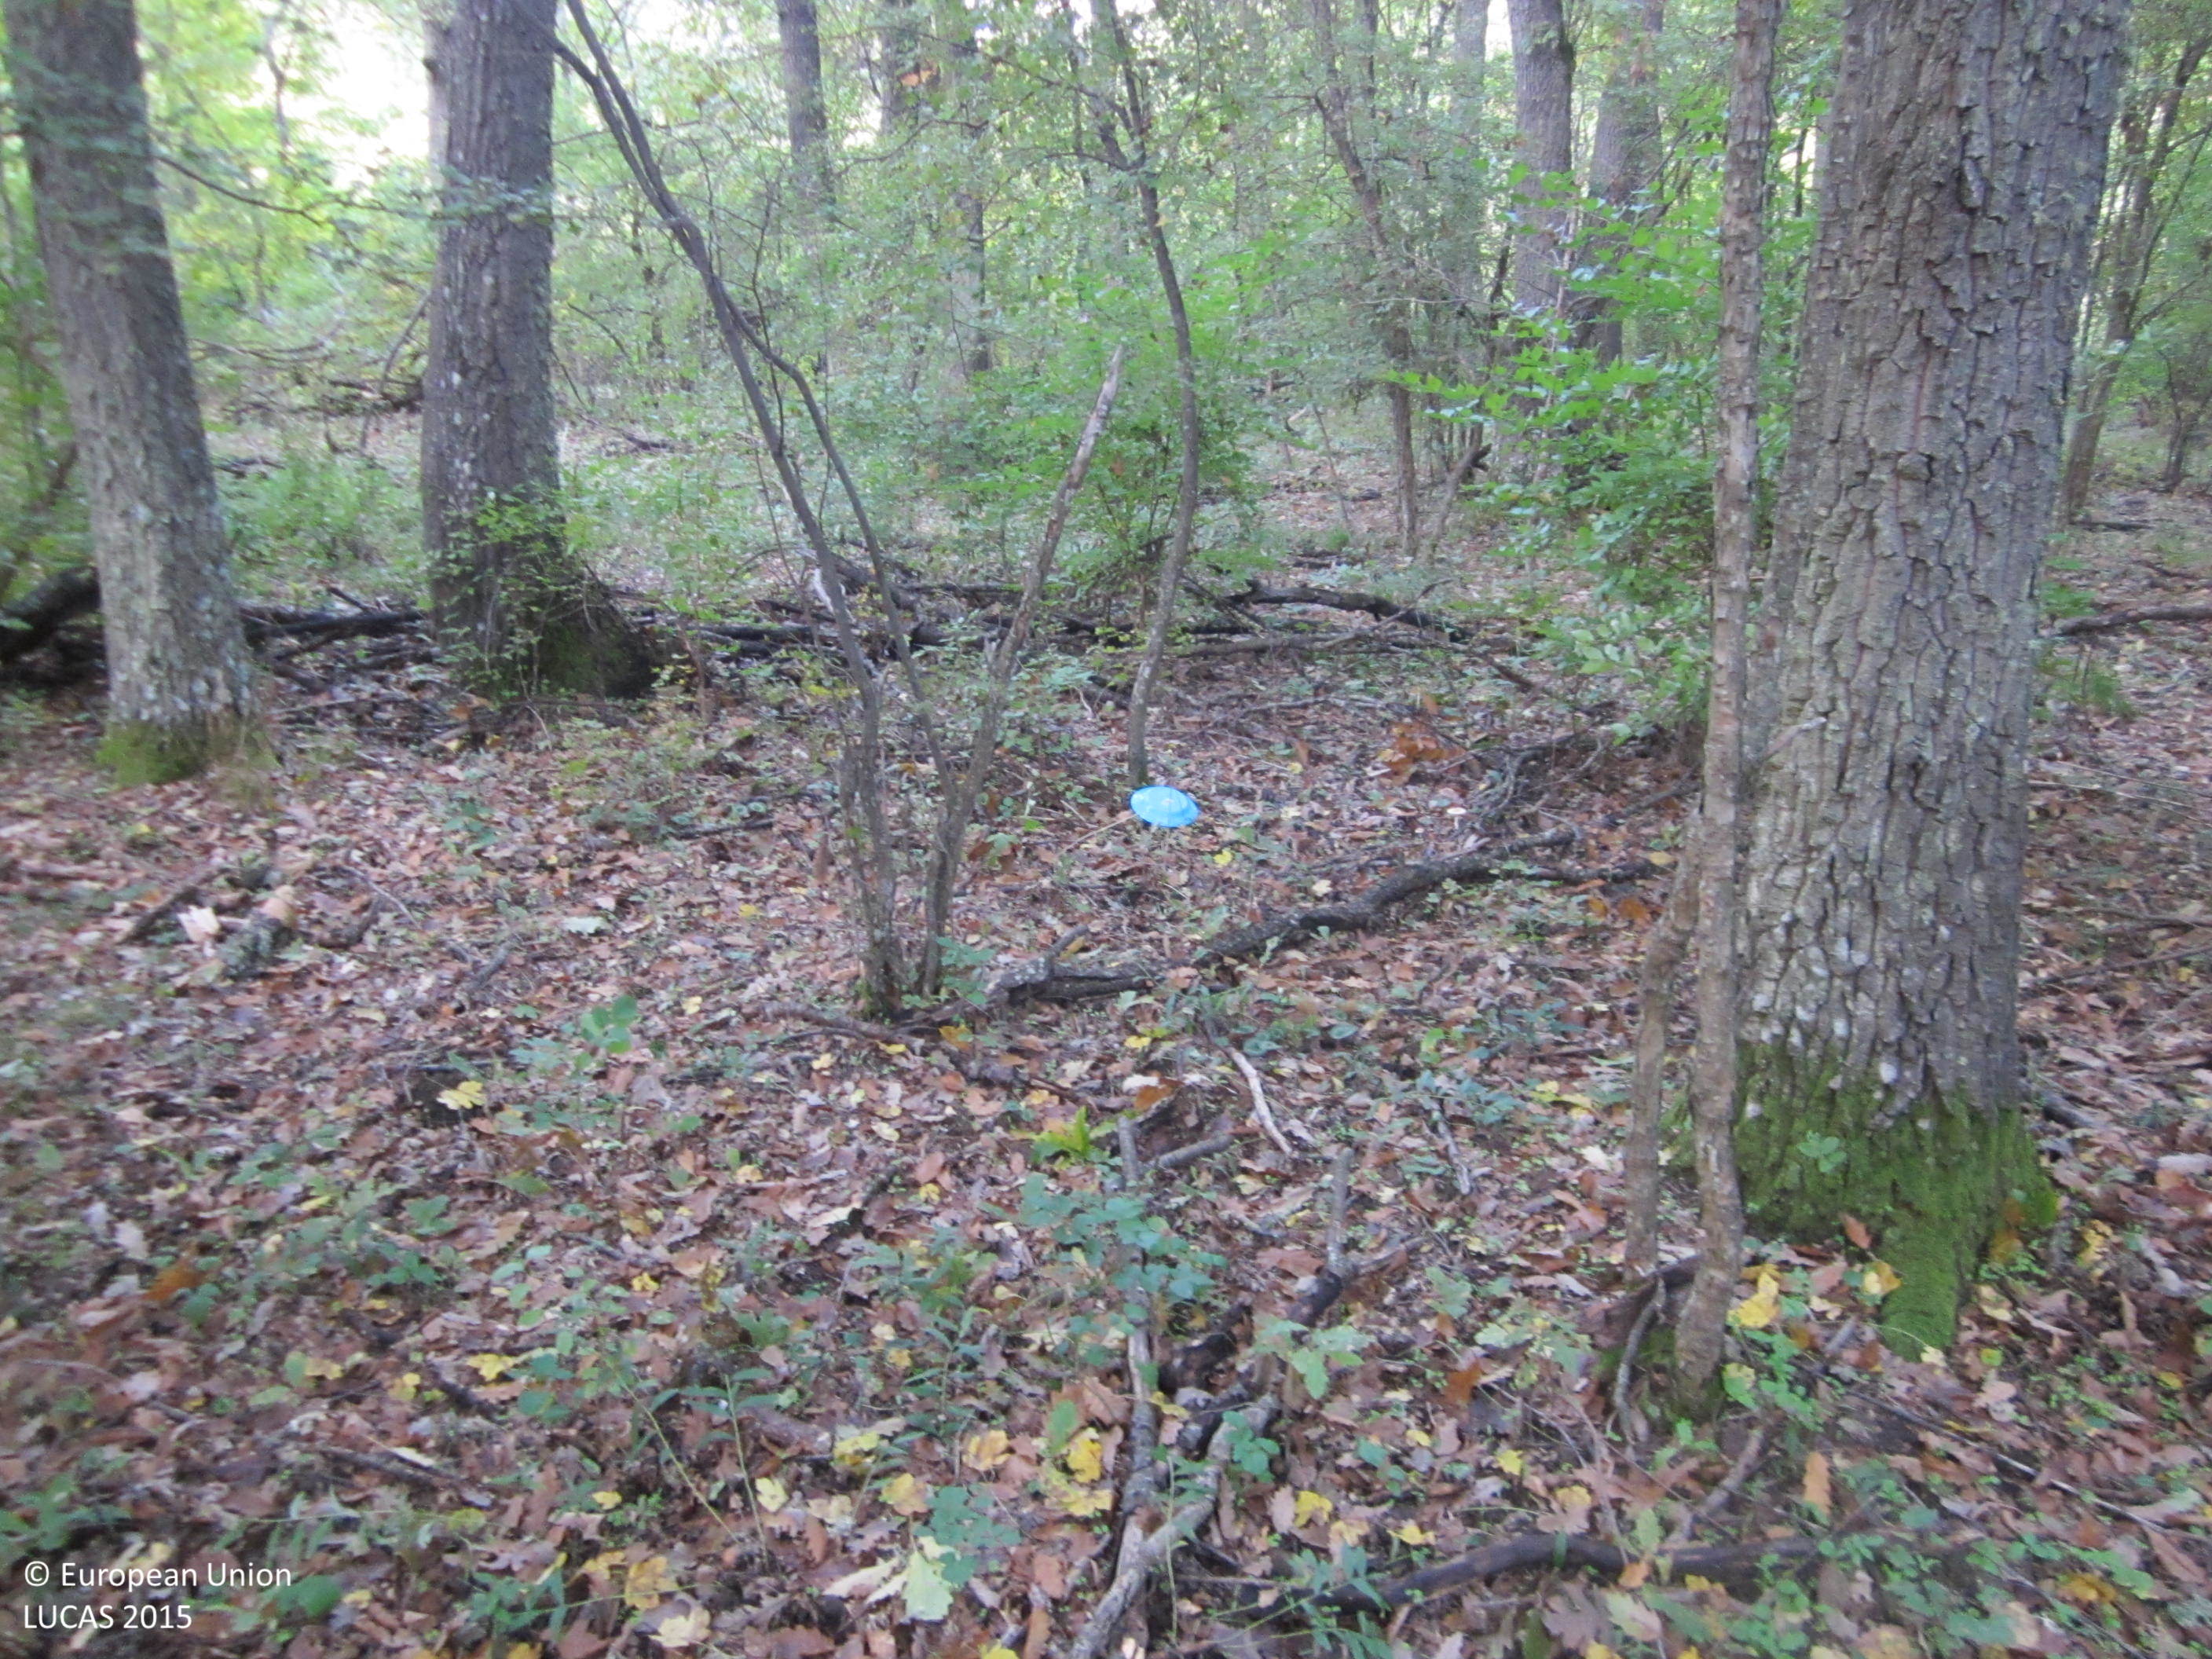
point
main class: Woodland
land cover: Broadleaved woodland
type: mesophytic deciduous forest
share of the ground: > 75 %
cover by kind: broadleaved forest trees 90 %, herbaceous plants 5 %, unconsolidated bare surface 5 %
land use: Forestry
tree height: > 5 m
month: October
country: BG
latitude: 42.1899
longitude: 27.2655
